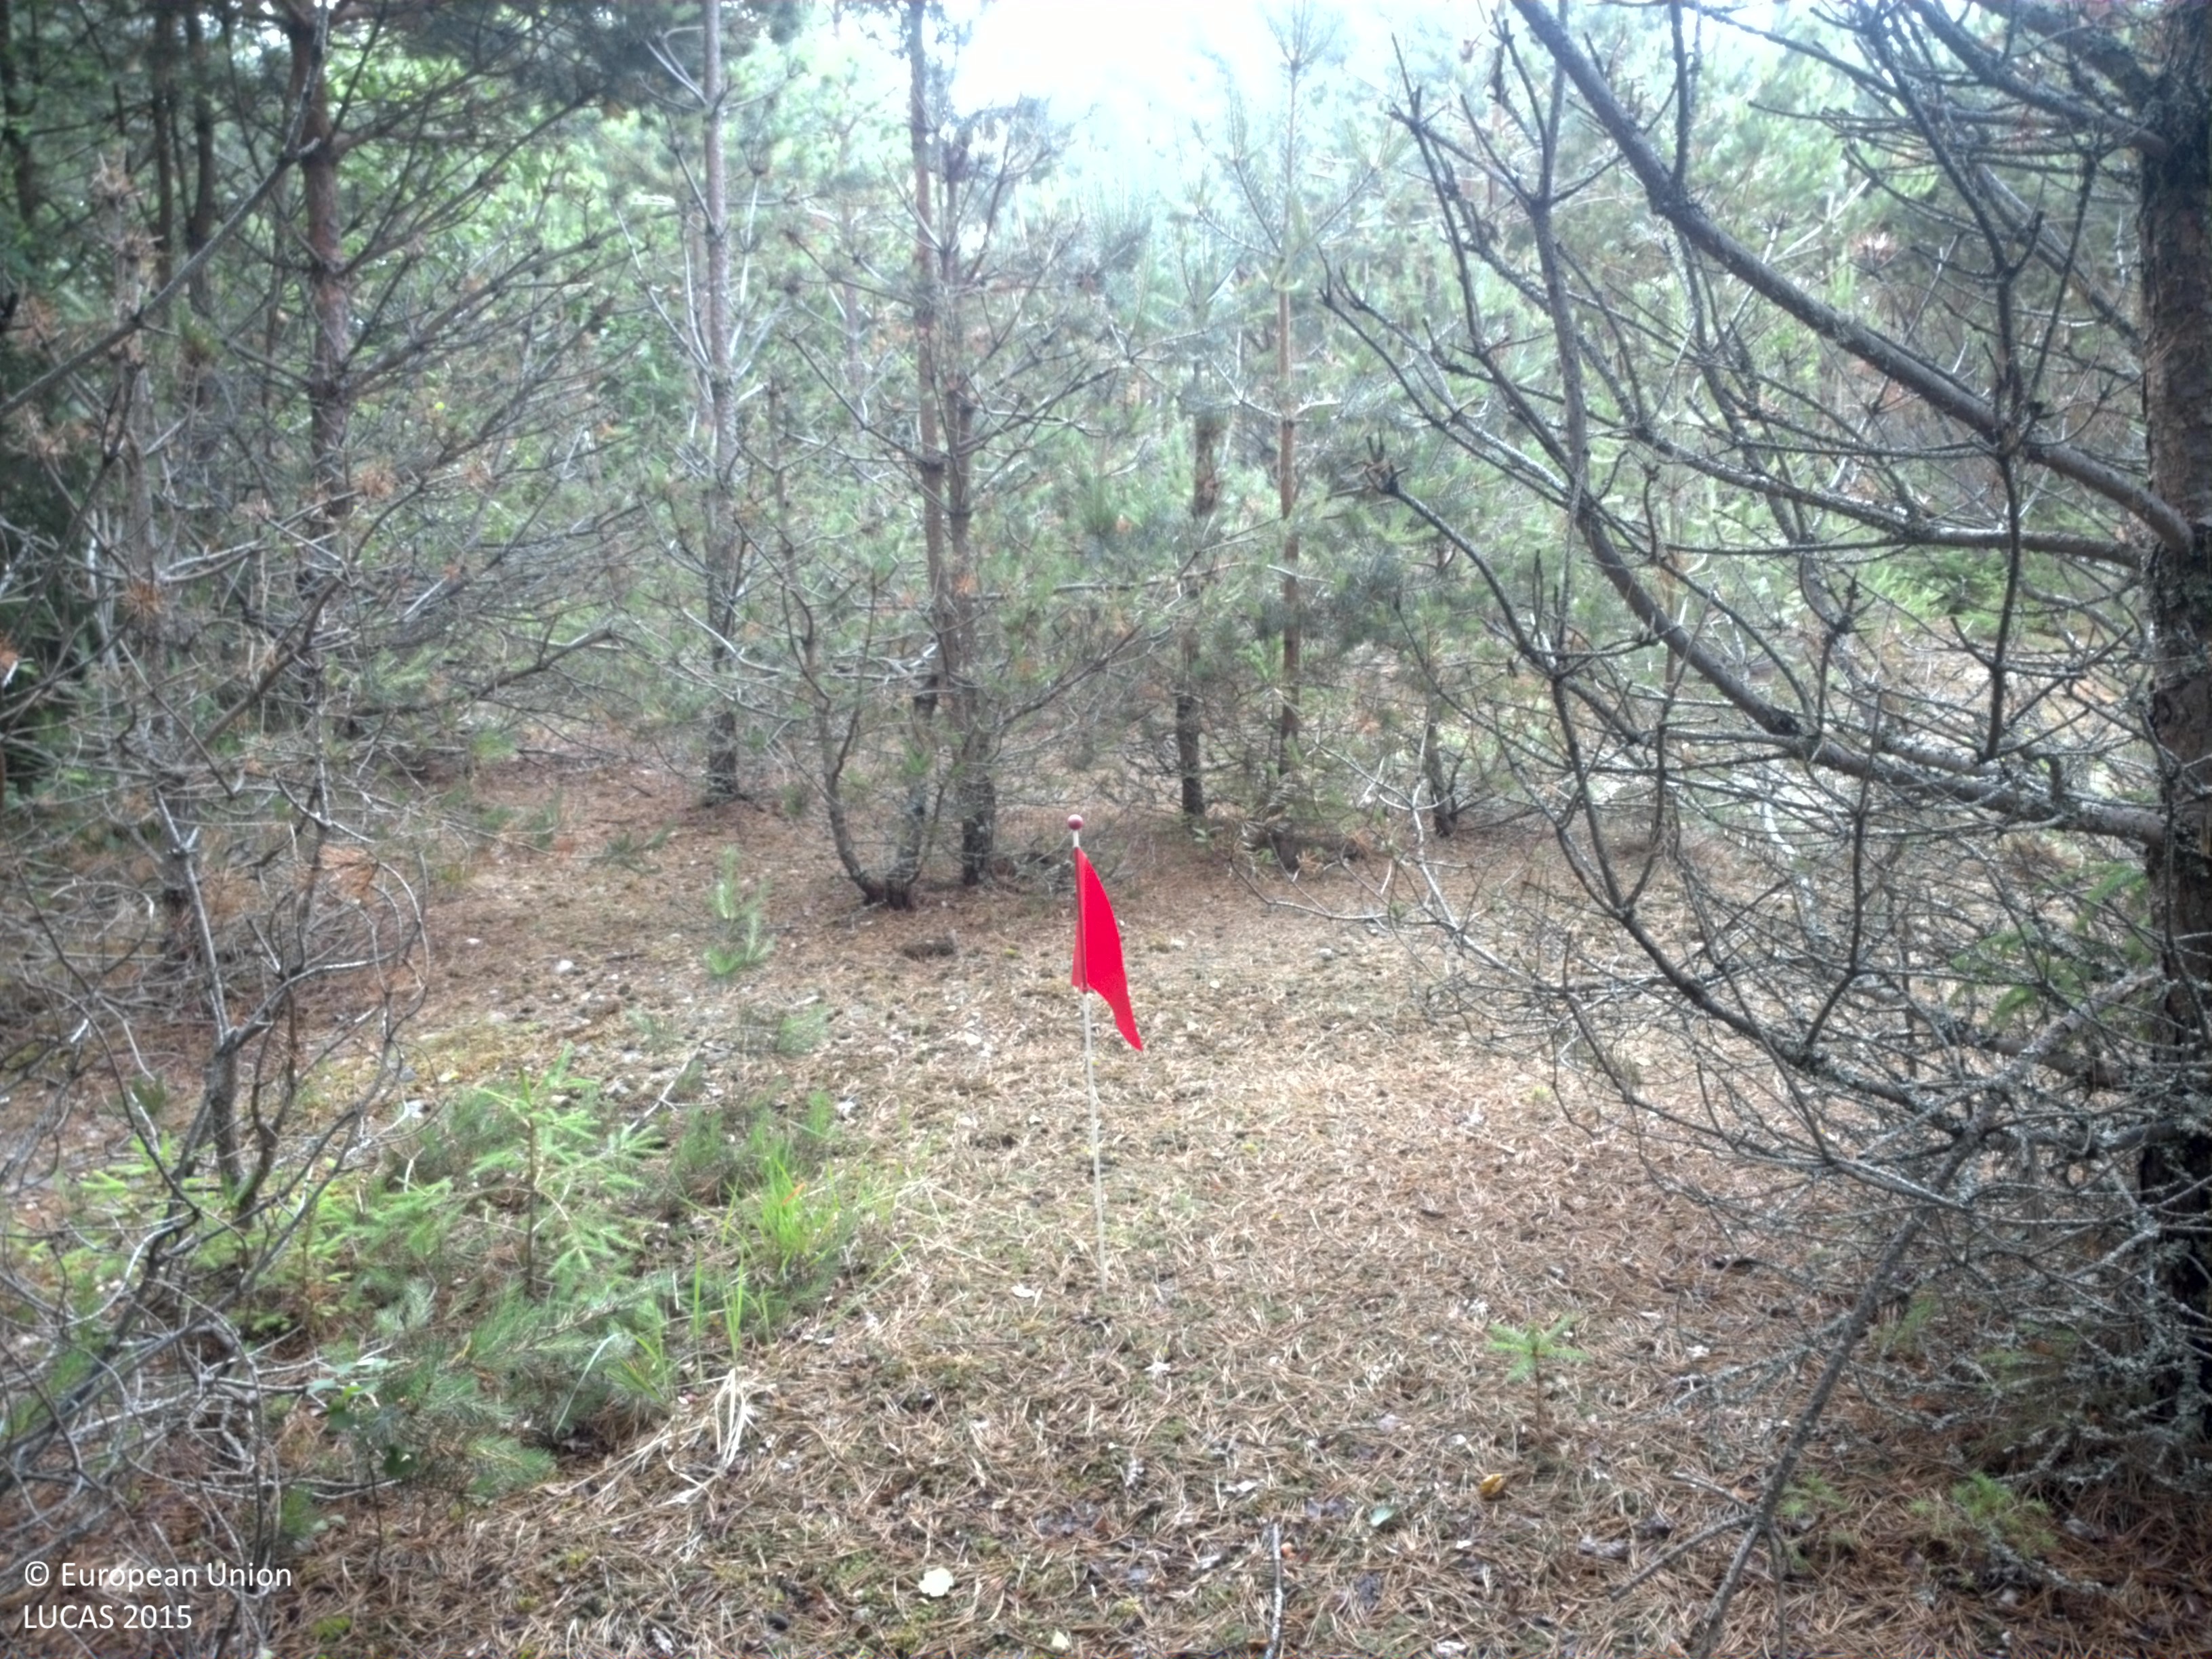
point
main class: Woodland
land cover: Pine dominated coniferous woodland
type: boreal forest
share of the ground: 10 - 25 %
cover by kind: consolidated bare surface 65 %, coniferous forest trees 20 %, broadleaved forest trees 5 %, shrubs 5 %, lichens and mosses 5 %
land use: Forestry
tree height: < 5 m
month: July
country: SE
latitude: 59.2959
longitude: 12.3996
